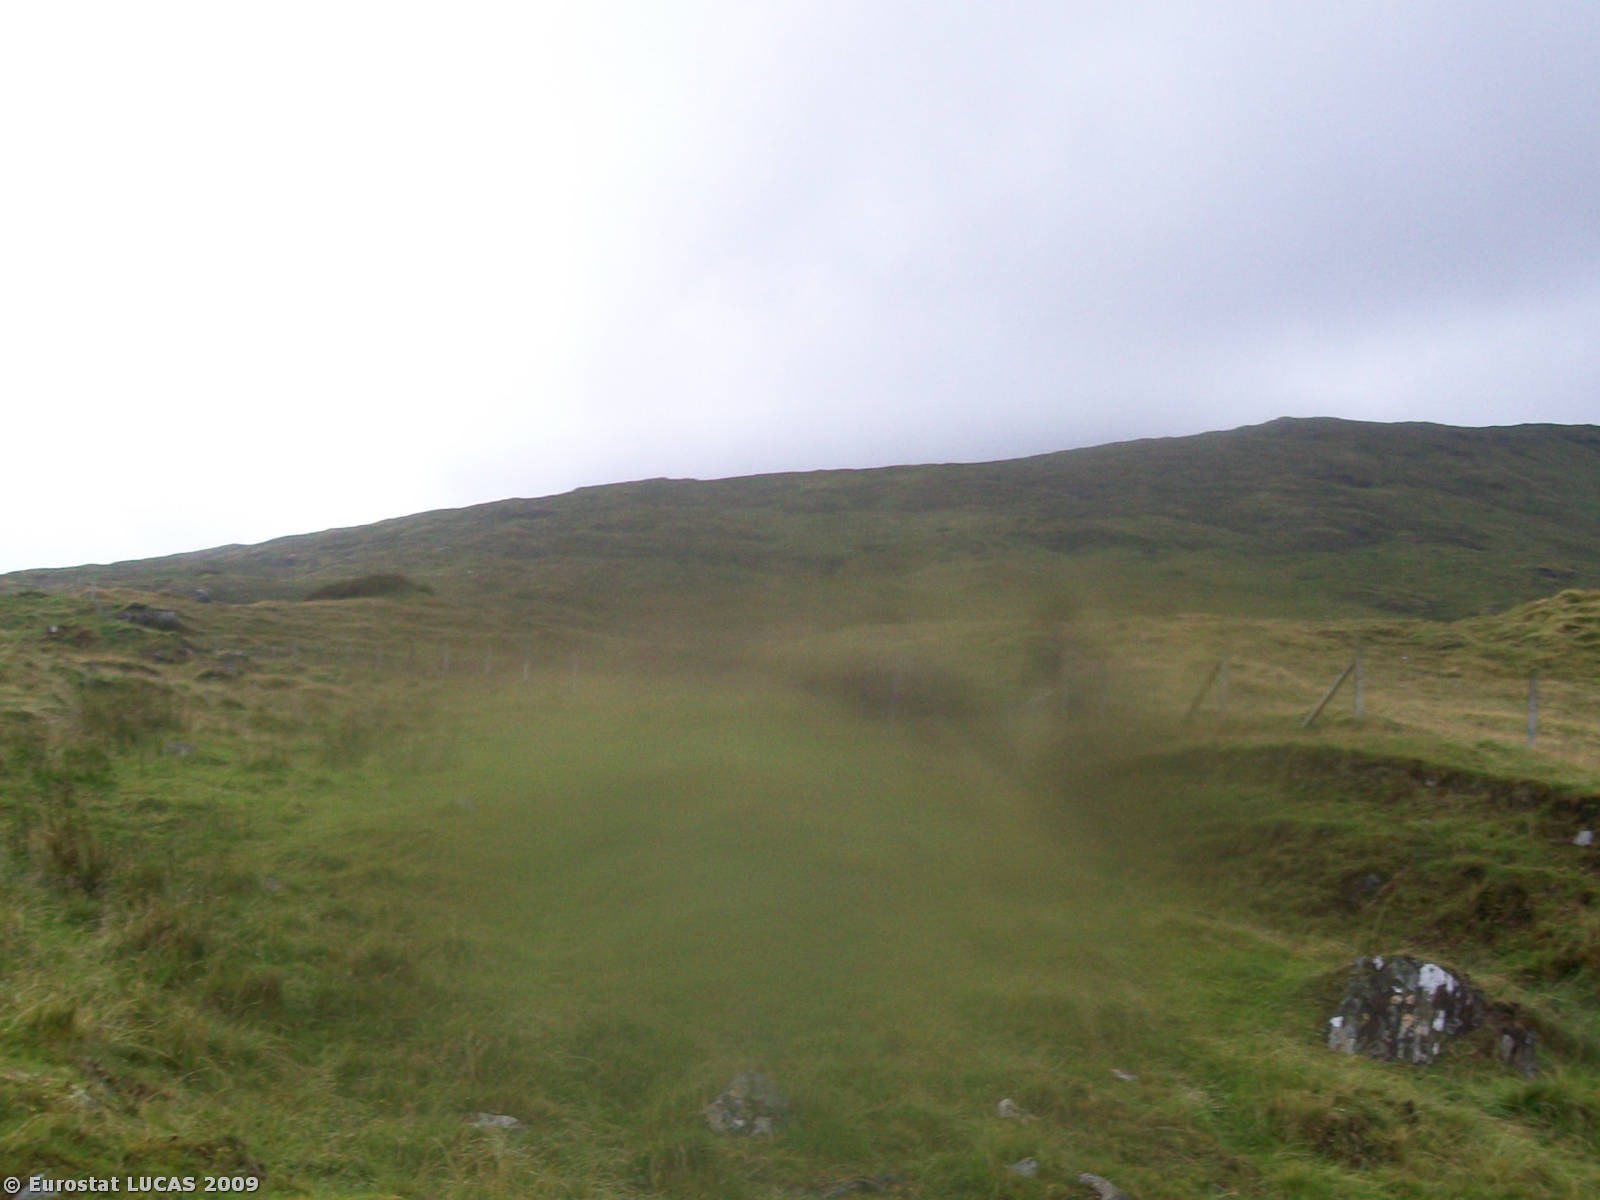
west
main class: Grassland
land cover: Grassland without tree/shrub cover
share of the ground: > 75 %
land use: Agriculture (excluding fallow land and kitchen gardens)
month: July
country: IE
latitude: 53.5405
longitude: -9.4708
